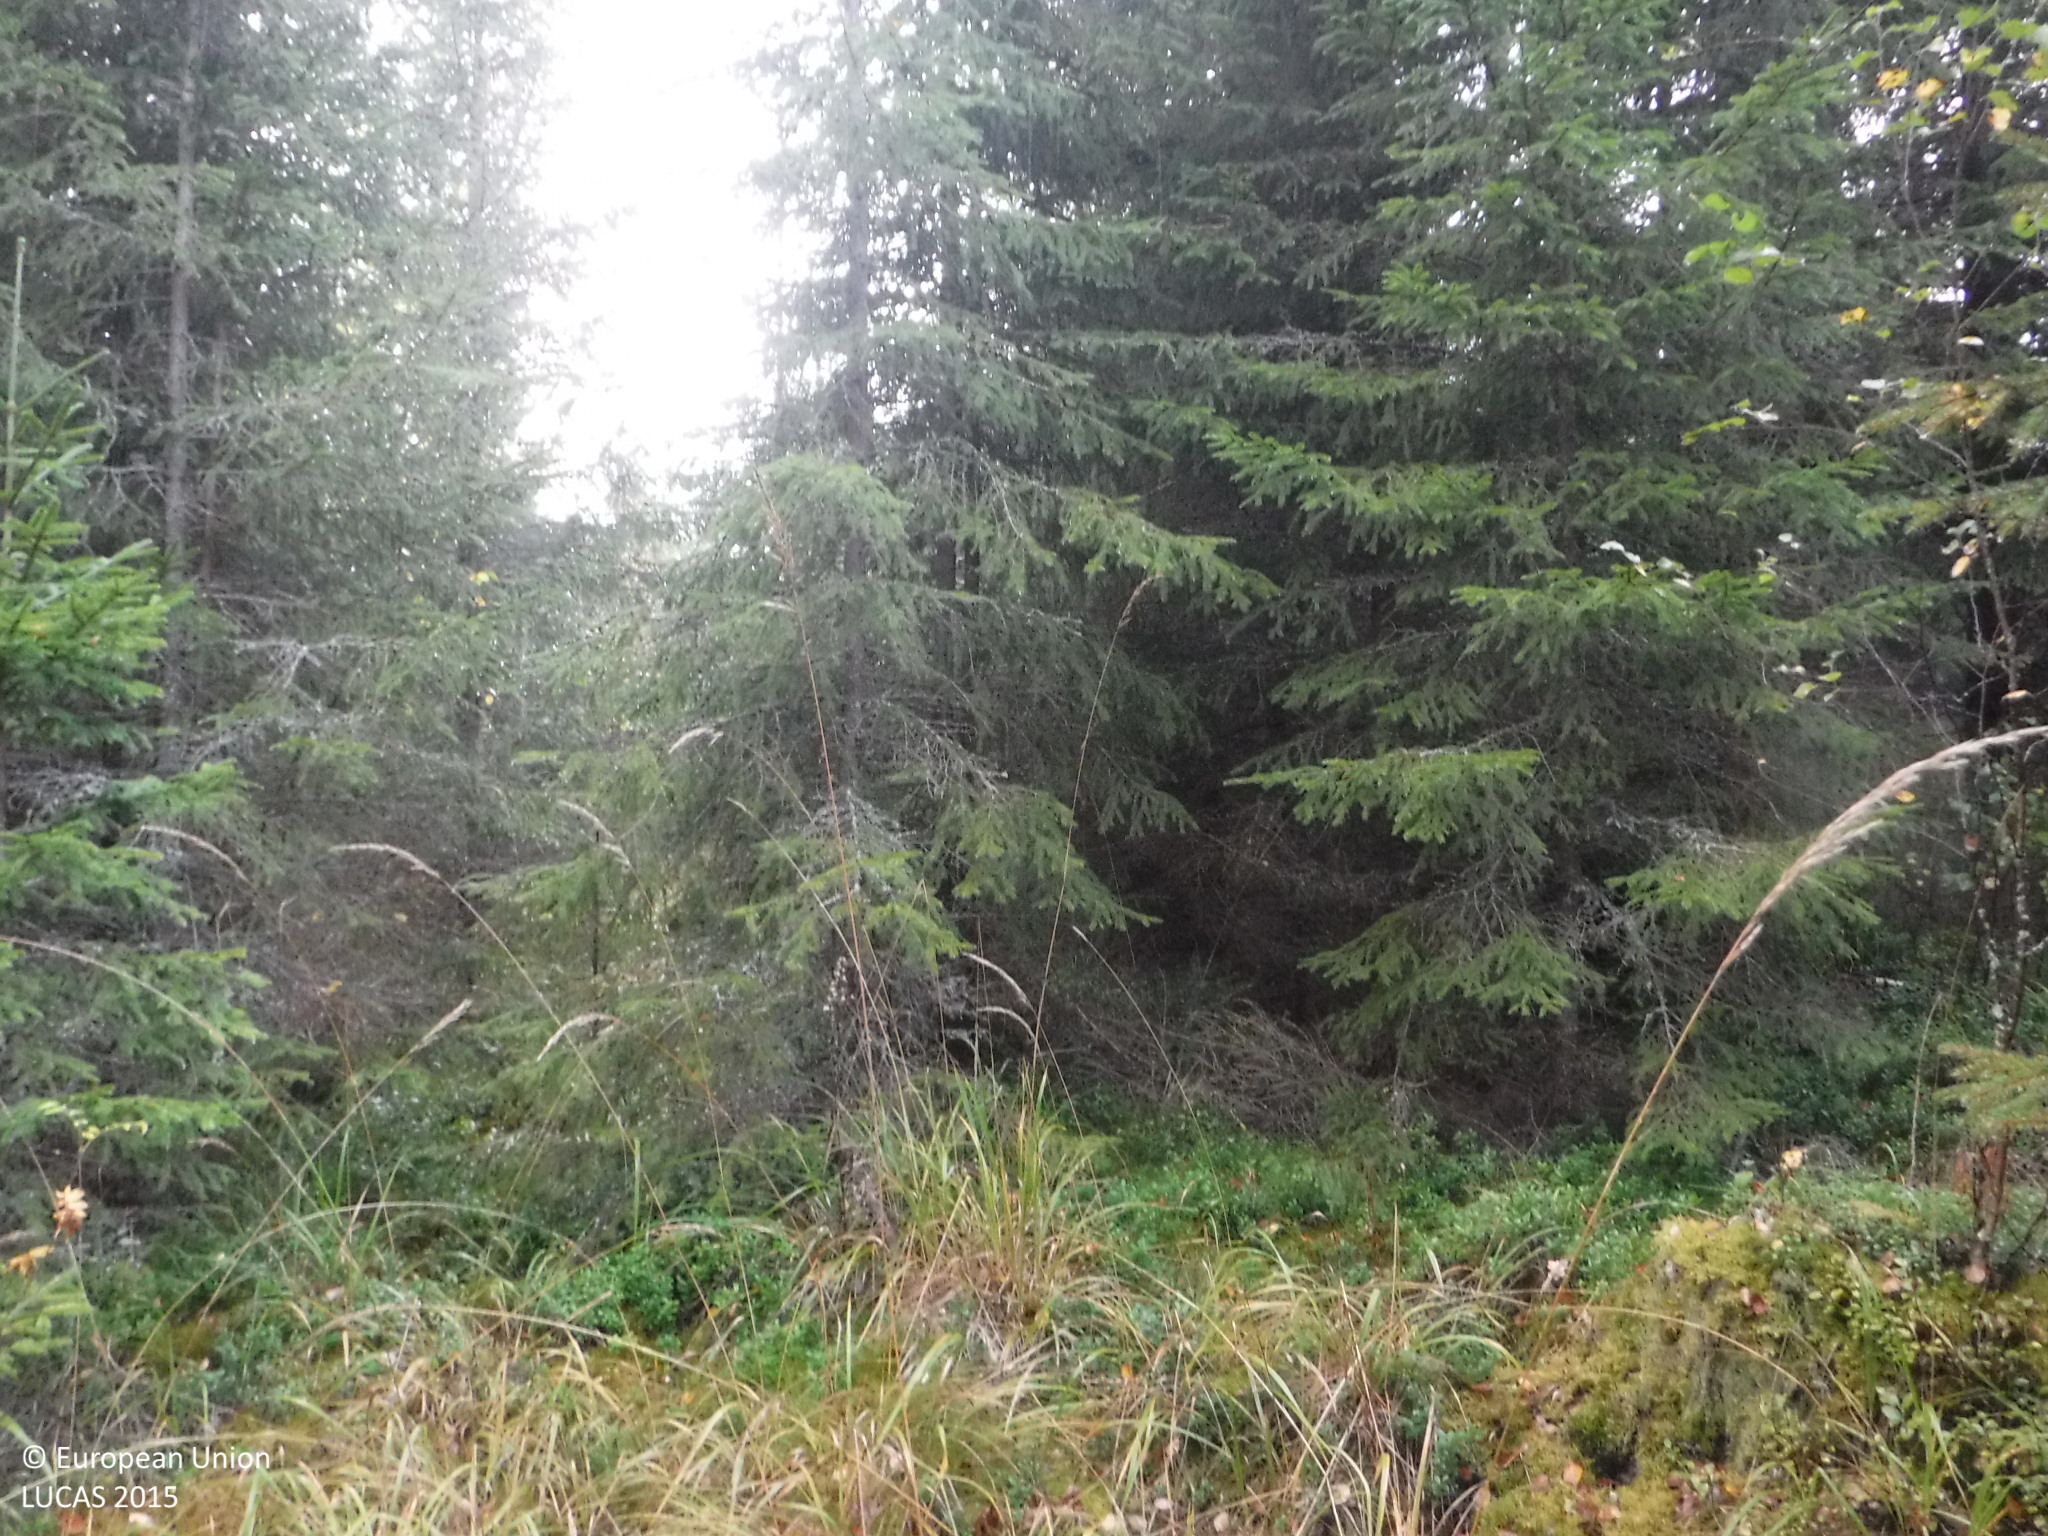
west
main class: Woodland
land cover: Spruce dominated coniferous woodland
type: boreal forest
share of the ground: 50 - 75 %
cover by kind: coniferous forest trees 55 %, herbaceous plants 40 %, lichens and mosses 5 %
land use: Forestry
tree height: > 5 m
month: September
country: FI
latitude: 61.7053
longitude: 24.1022
